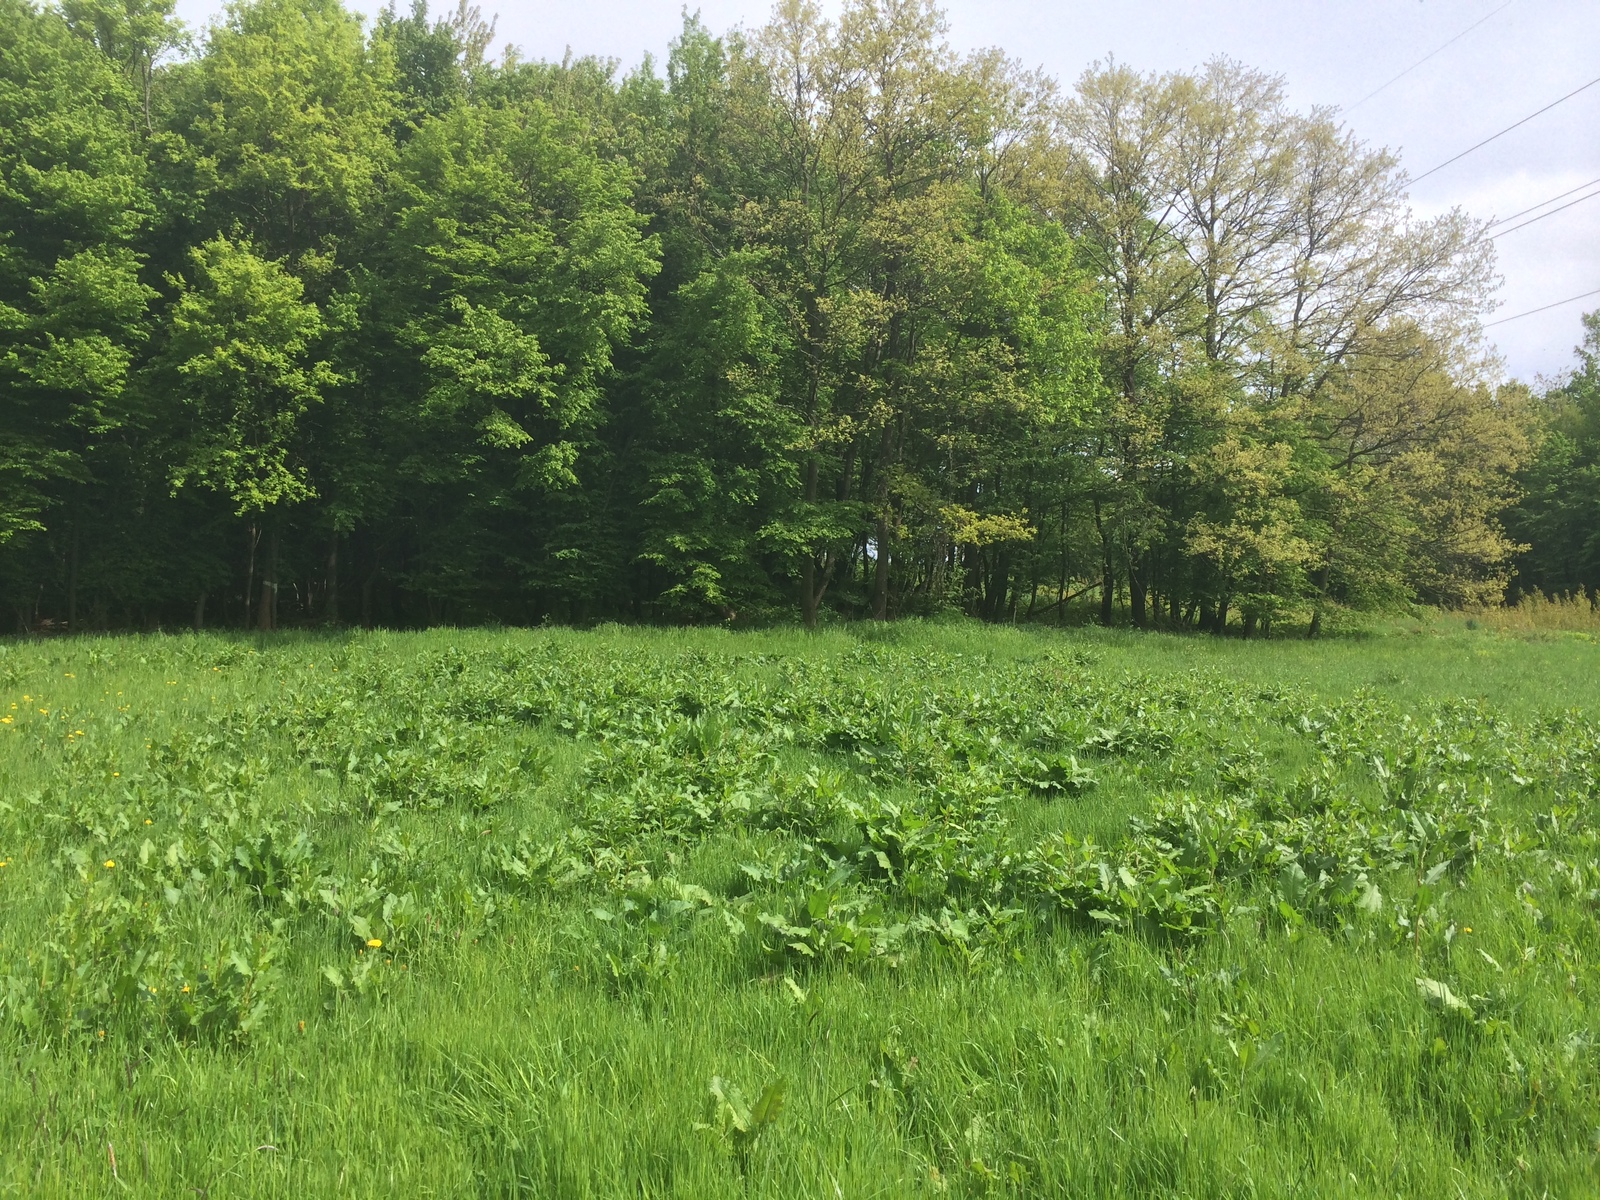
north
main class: Grassland
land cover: Grassland without tree/shrub cover
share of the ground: > 75 %
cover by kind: herbaceous plants 100 %
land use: Agriculture (excluding fallow land and kitchen gardens)
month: May
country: AT
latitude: 48.1259
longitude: 16.1170
